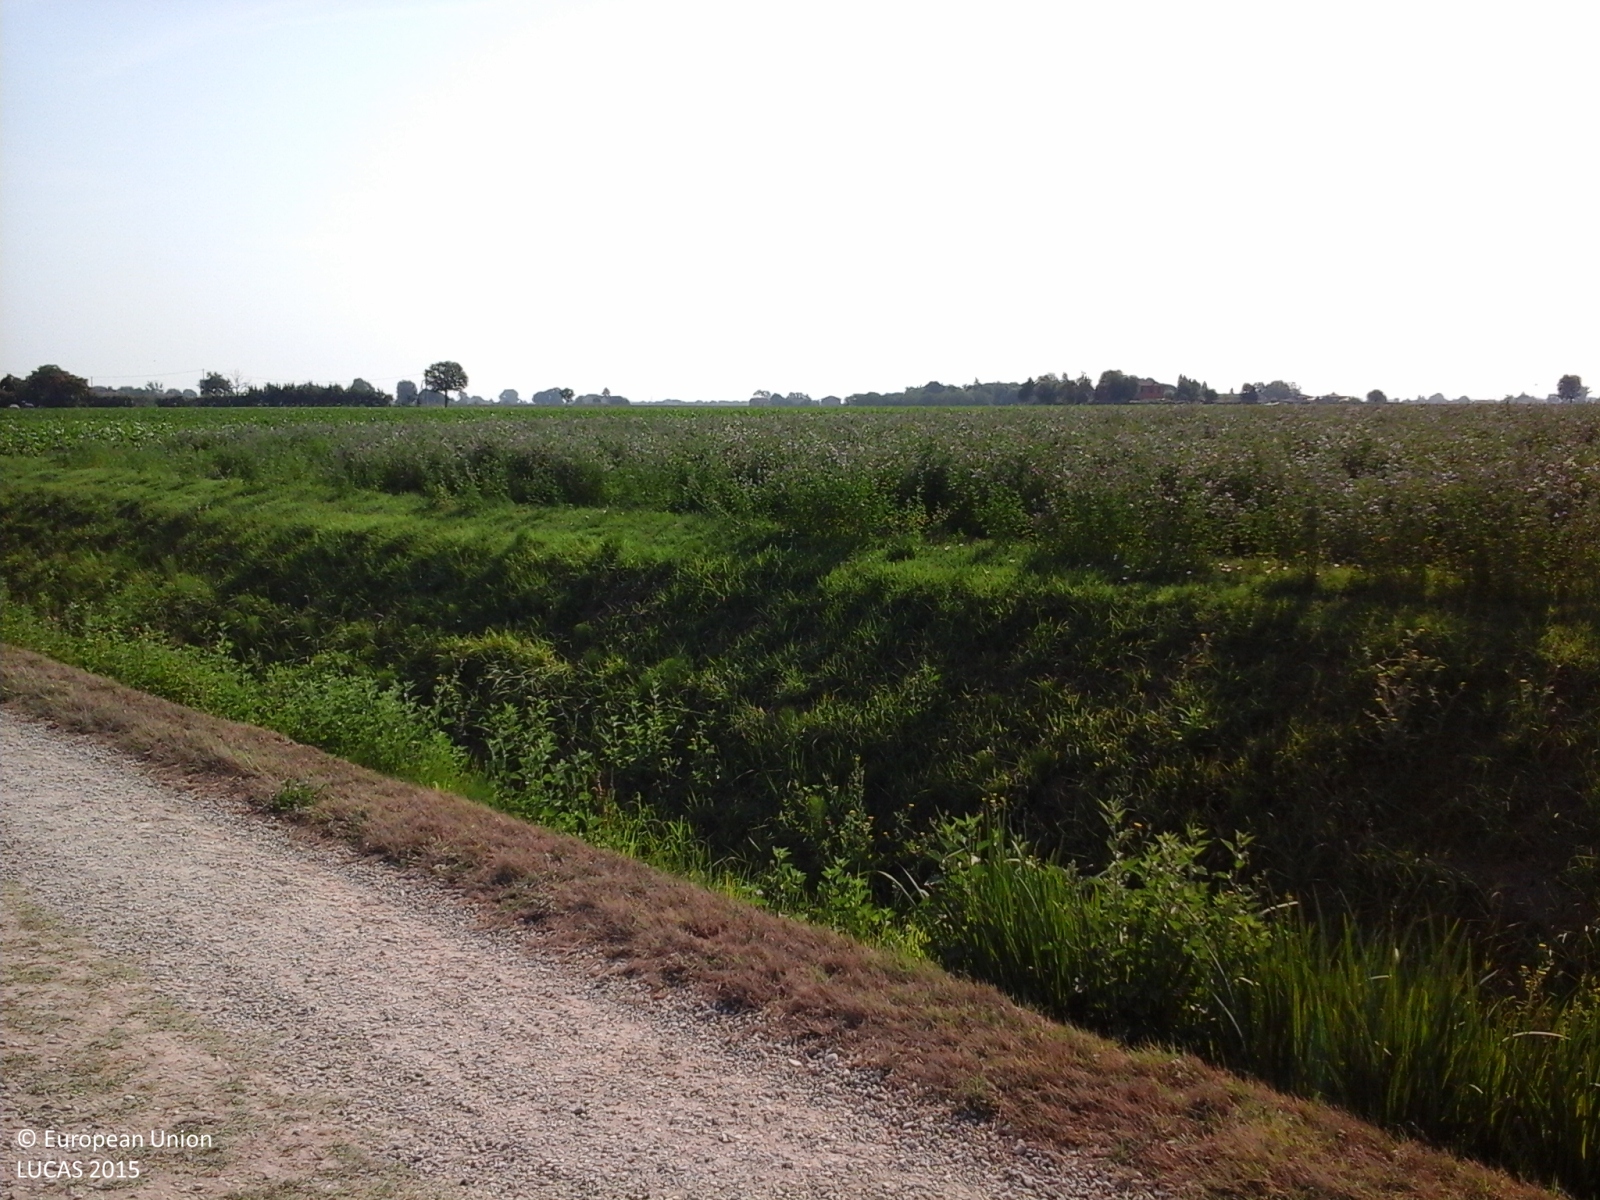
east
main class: Cropland
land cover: Barley
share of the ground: > 75 %
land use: Agriculture (excluding fallow land and kitchen gardens)
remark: Harvested field
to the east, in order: Grass margins; Paved roads, cycling and walking lanes; Grass margins; Ditches and canals; Grass margins; Lucerne; Grass margins; Ditches and canals; Grass margins; Sugar beet; Ditches and canals; Sugar beet
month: July
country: IT
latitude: 44.4638
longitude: 11.6430
